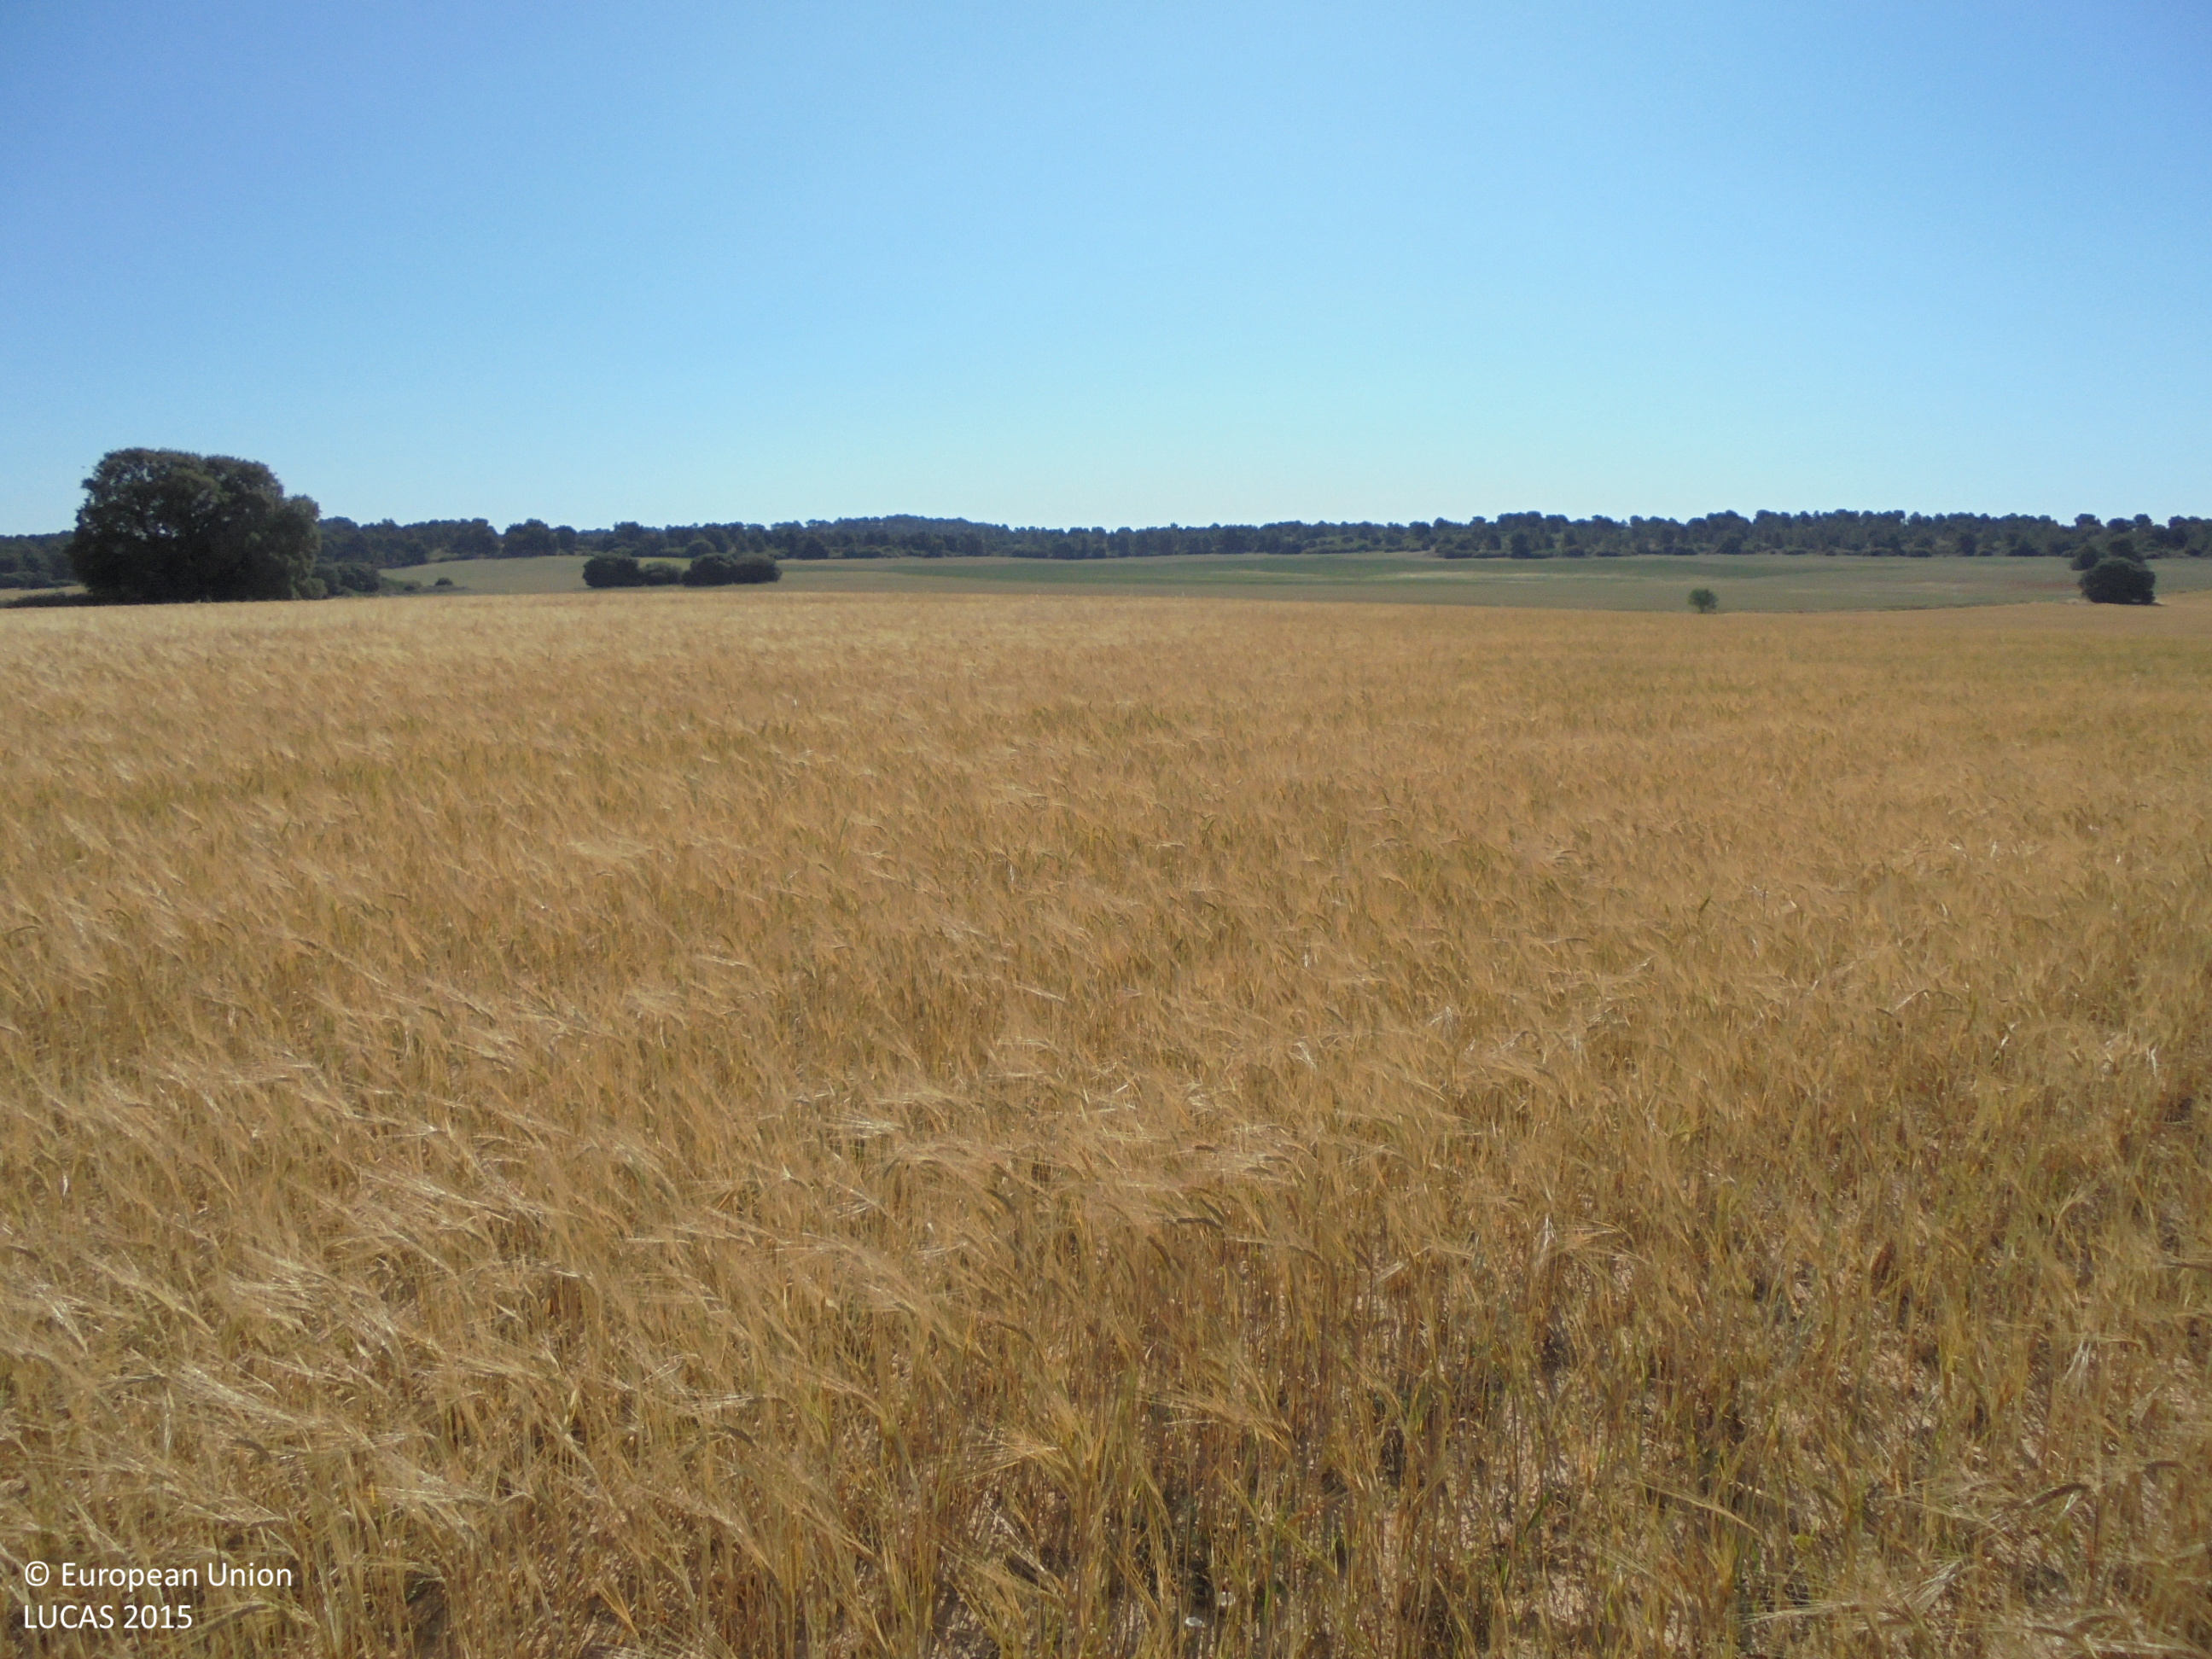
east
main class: Cropland
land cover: Barley
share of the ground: 50 - 75 %
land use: Agriculture (excluding fallow land and kitchen gardens)
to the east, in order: Barley; Grass margins; Rye
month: June
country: ES
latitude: 38.7841
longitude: -1.6579
